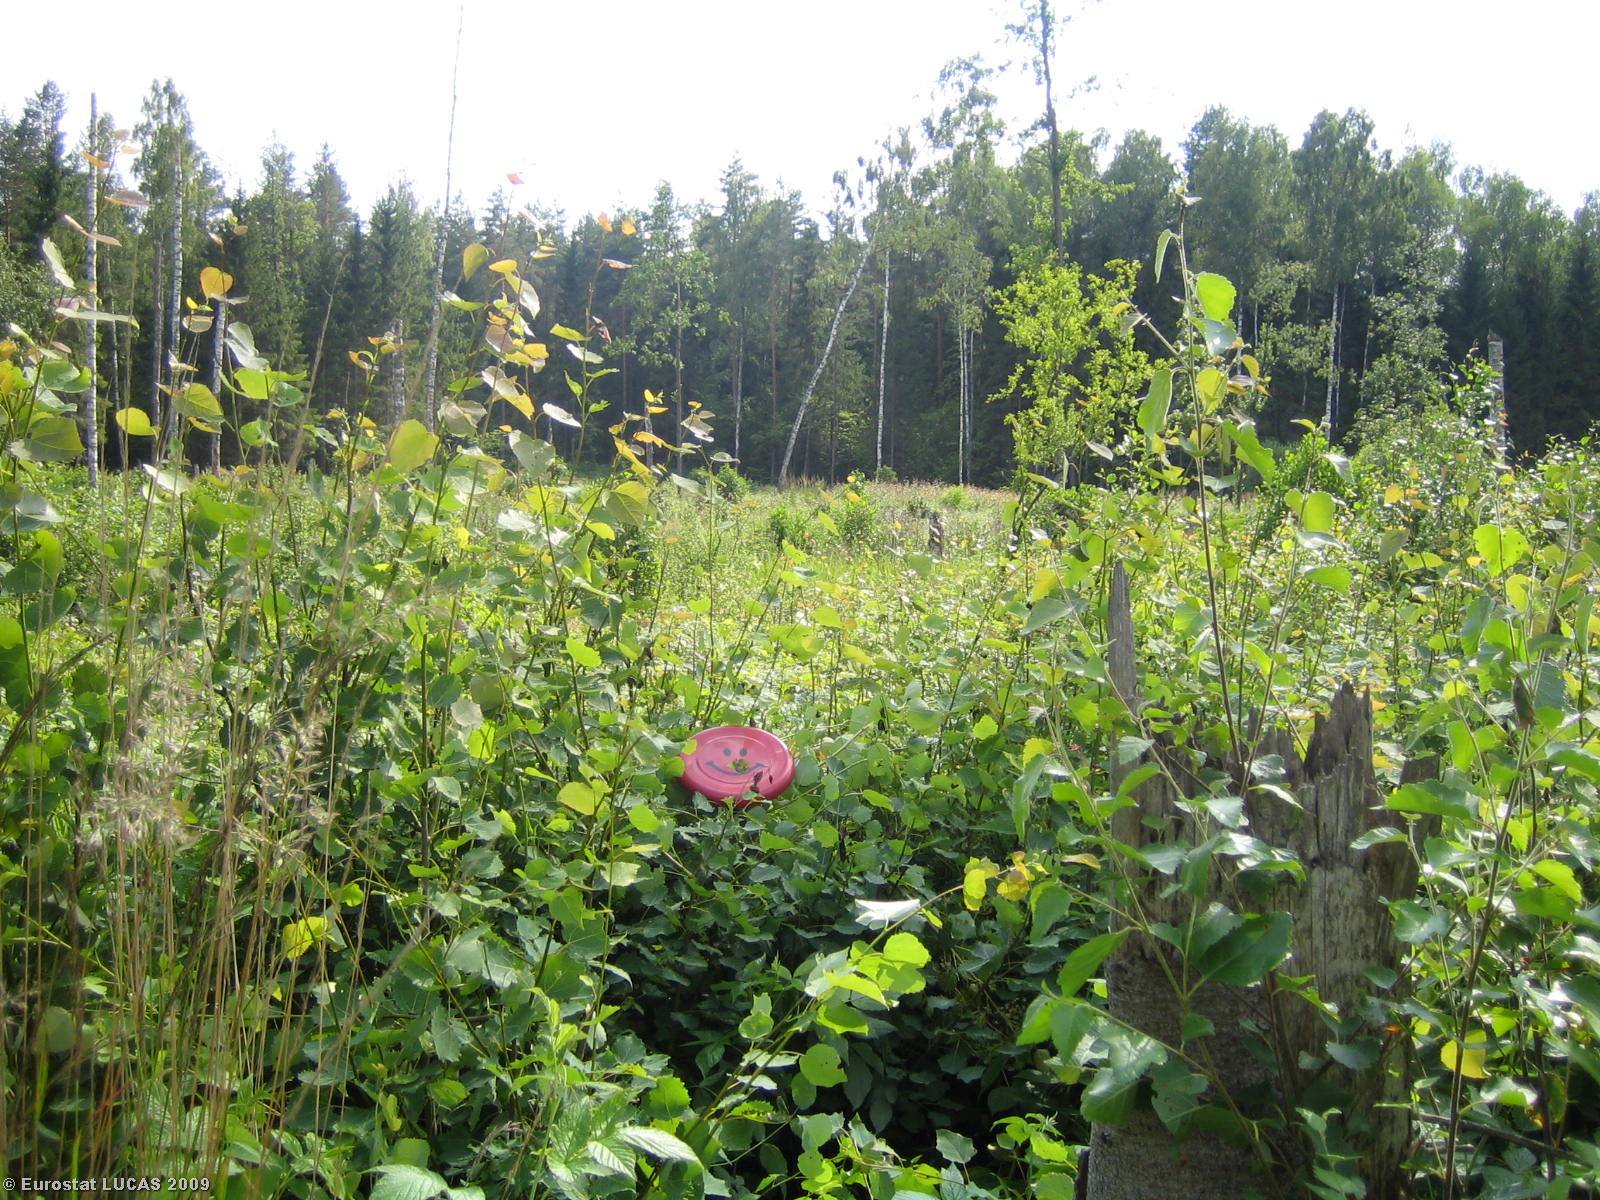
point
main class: Woodland
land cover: Mixed woodland
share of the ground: > 75 %
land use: Forestry
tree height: < 5 m
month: July
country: LT
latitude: 55.6889
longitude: 25.9963
